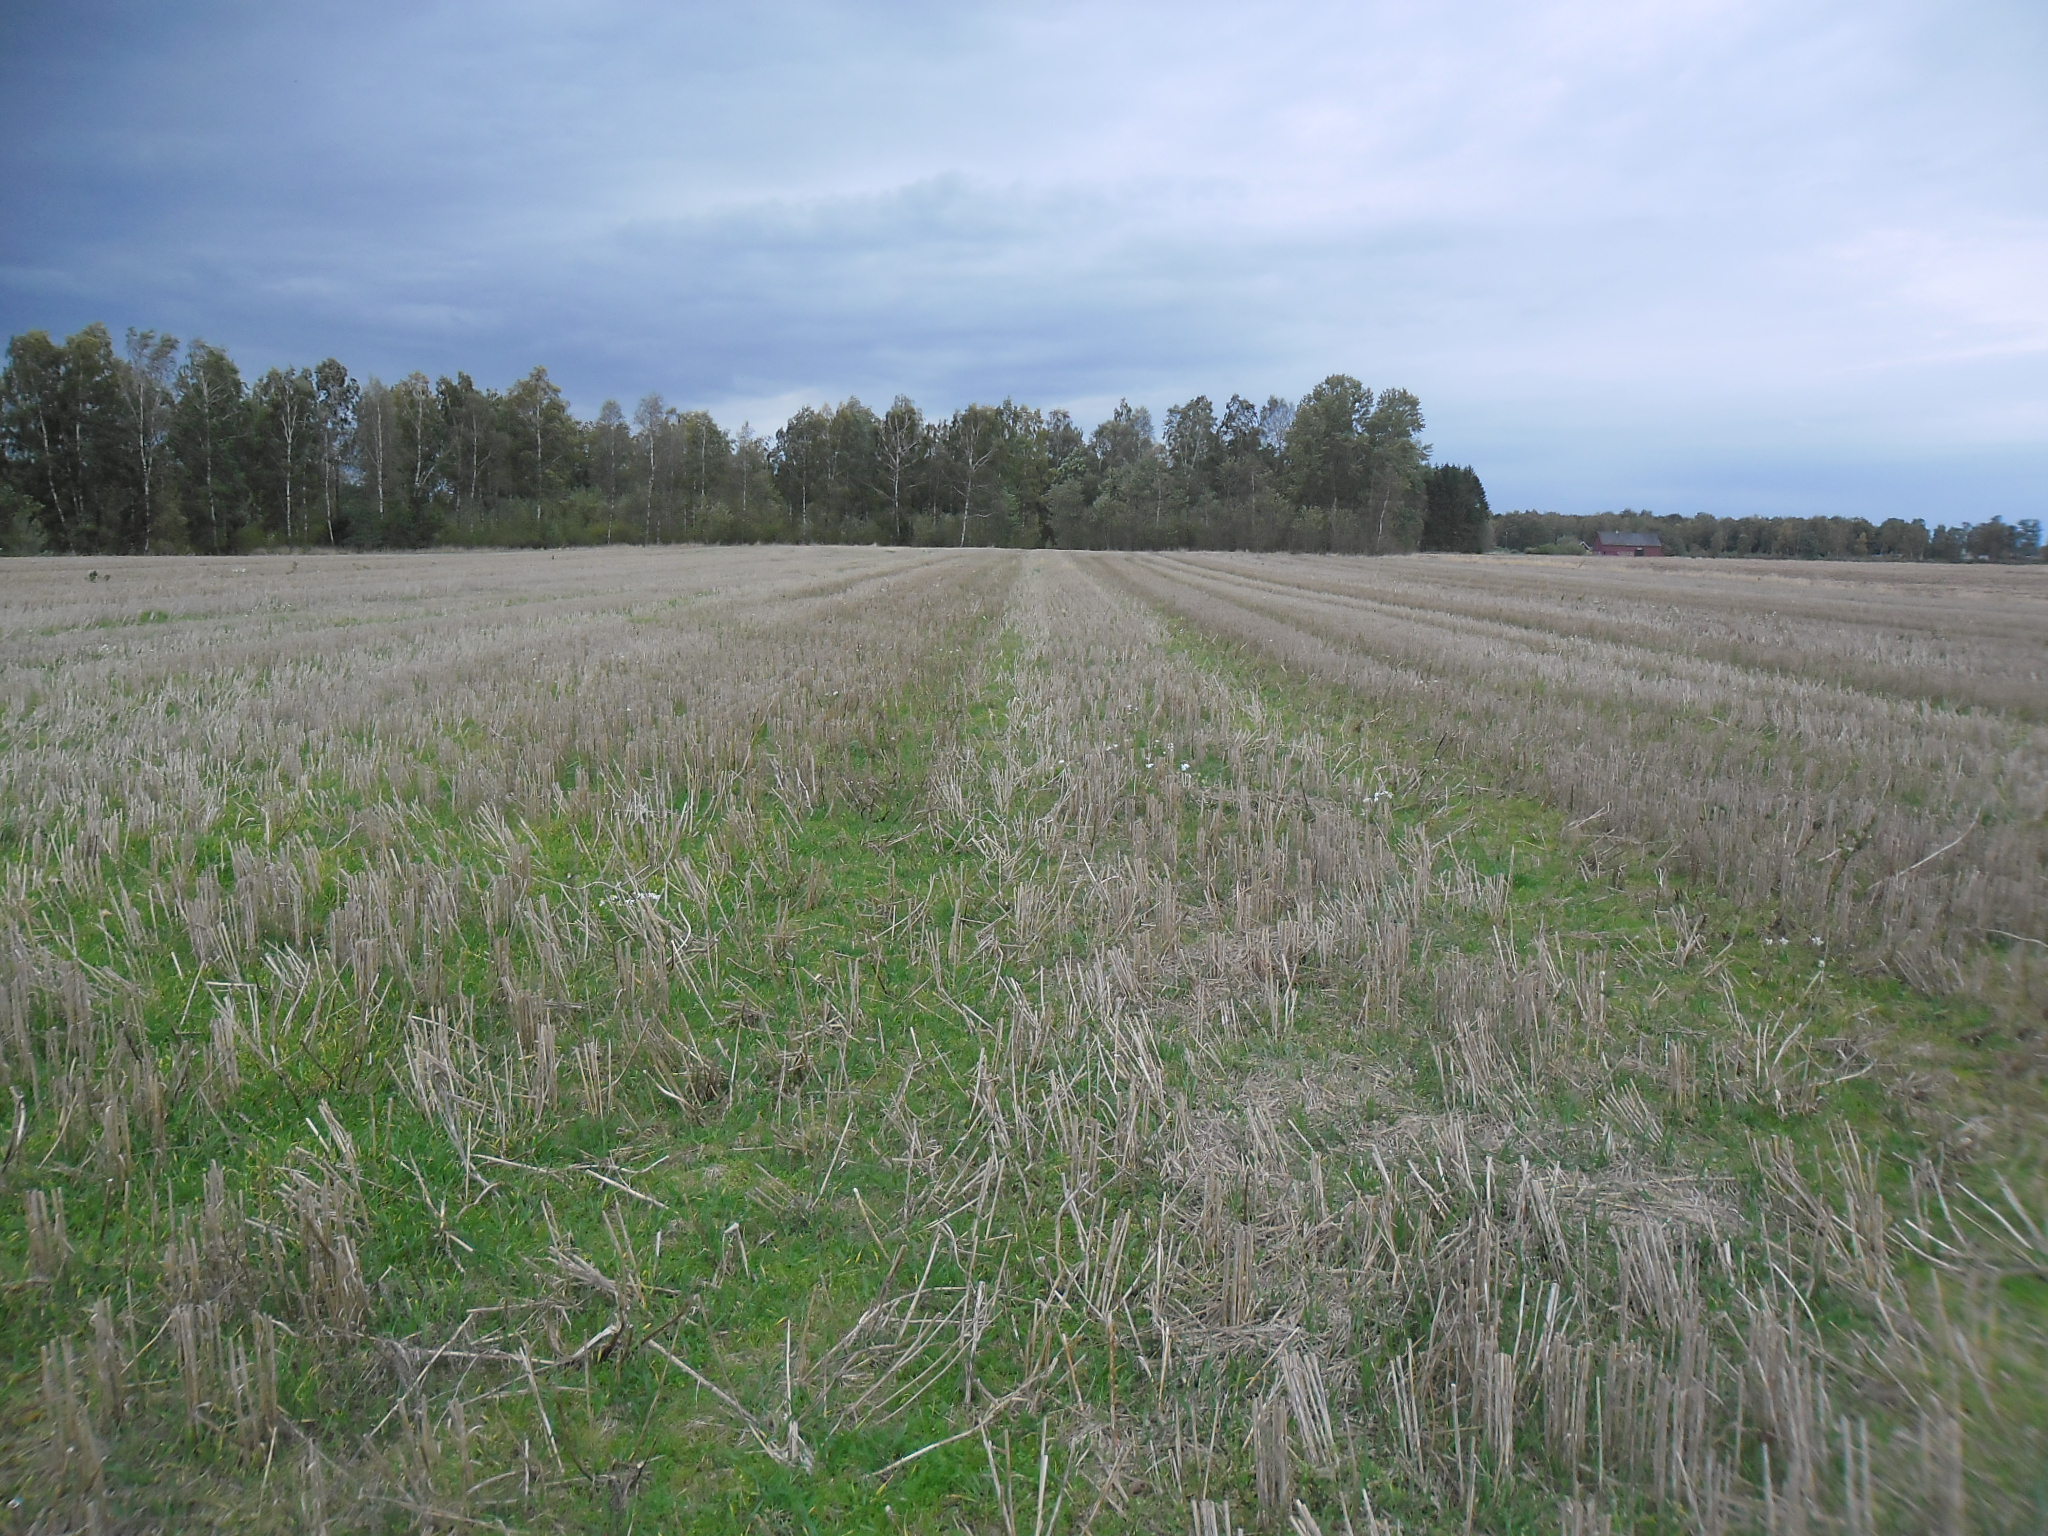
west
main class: Cropland
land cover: Barley
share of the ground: 10 - 25 %
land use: Agriculture (excluding fallow land and kitchen gardens)
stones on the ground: < 10 %
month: October
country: SE
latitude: 56.5281
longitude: 13.1021
